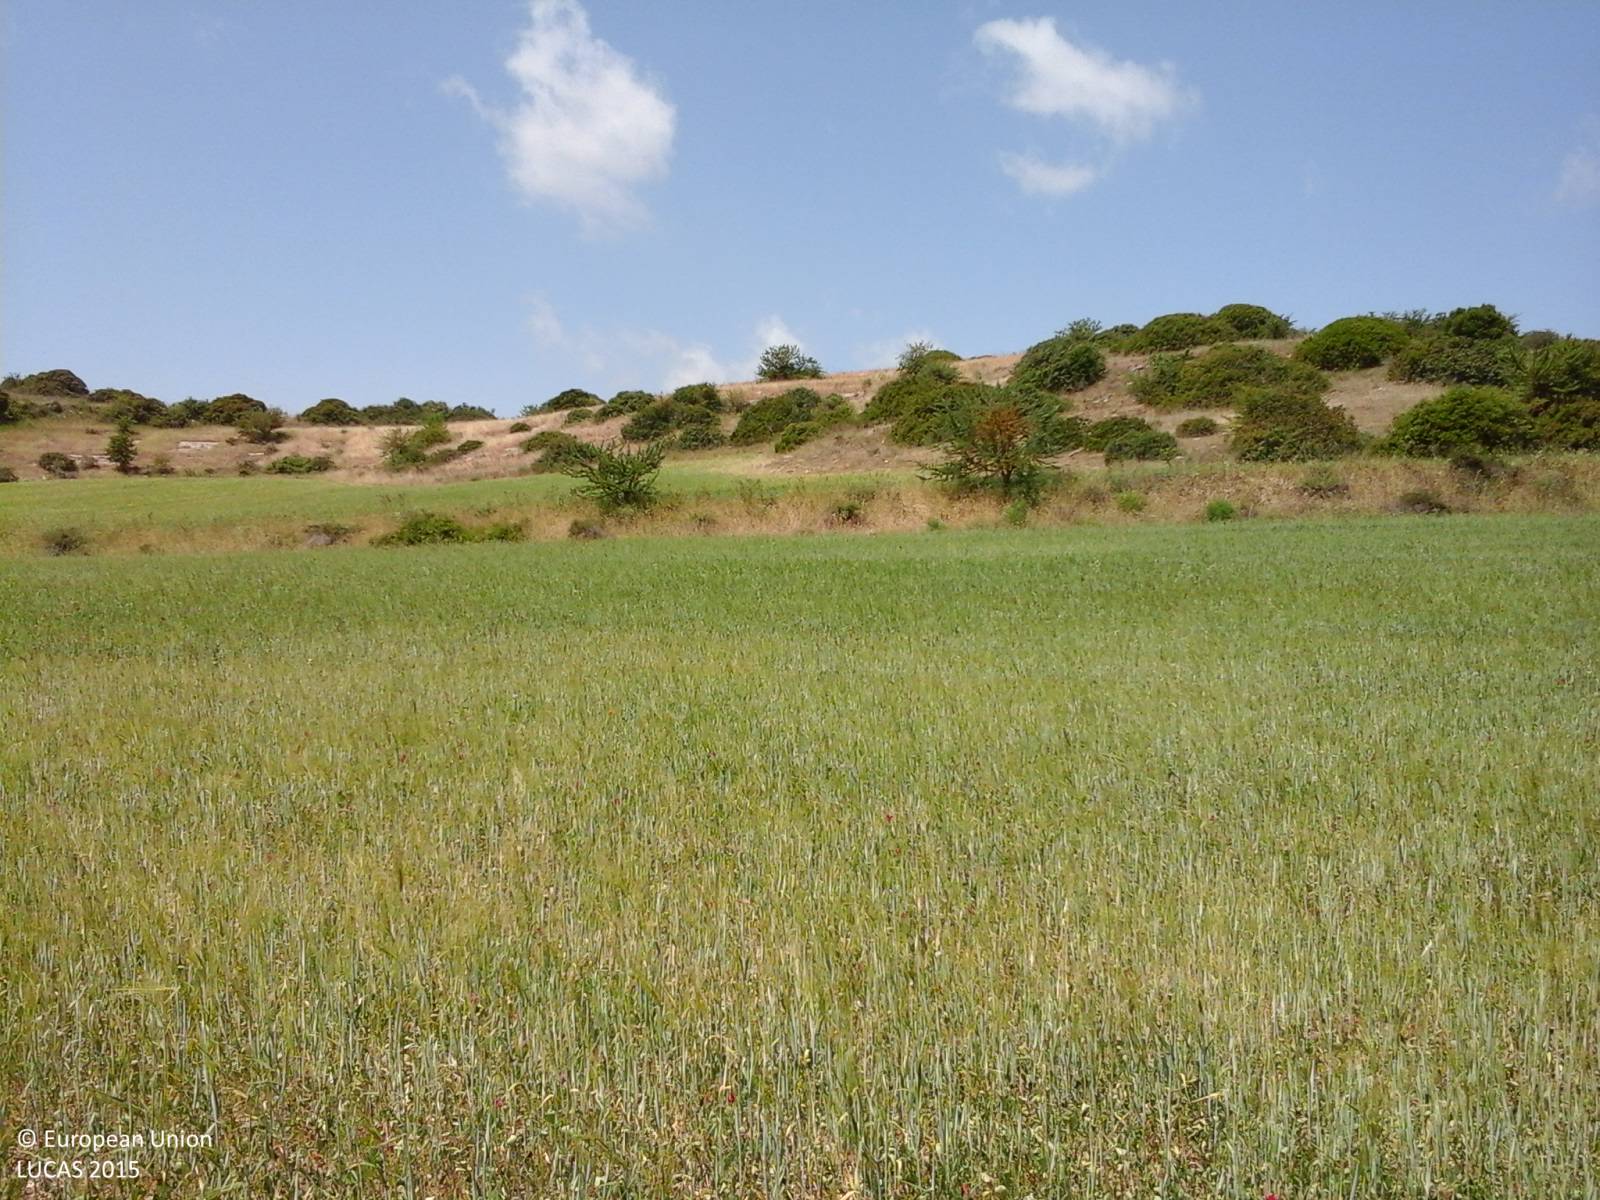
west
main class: Cropland
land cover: Other leguminous and mixtures for fodder
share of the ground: > 75 %
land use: Agriculture (excluding fallow land and kitchen gardens)
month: May
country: IT
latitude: 39.8082
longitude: 8.8733
